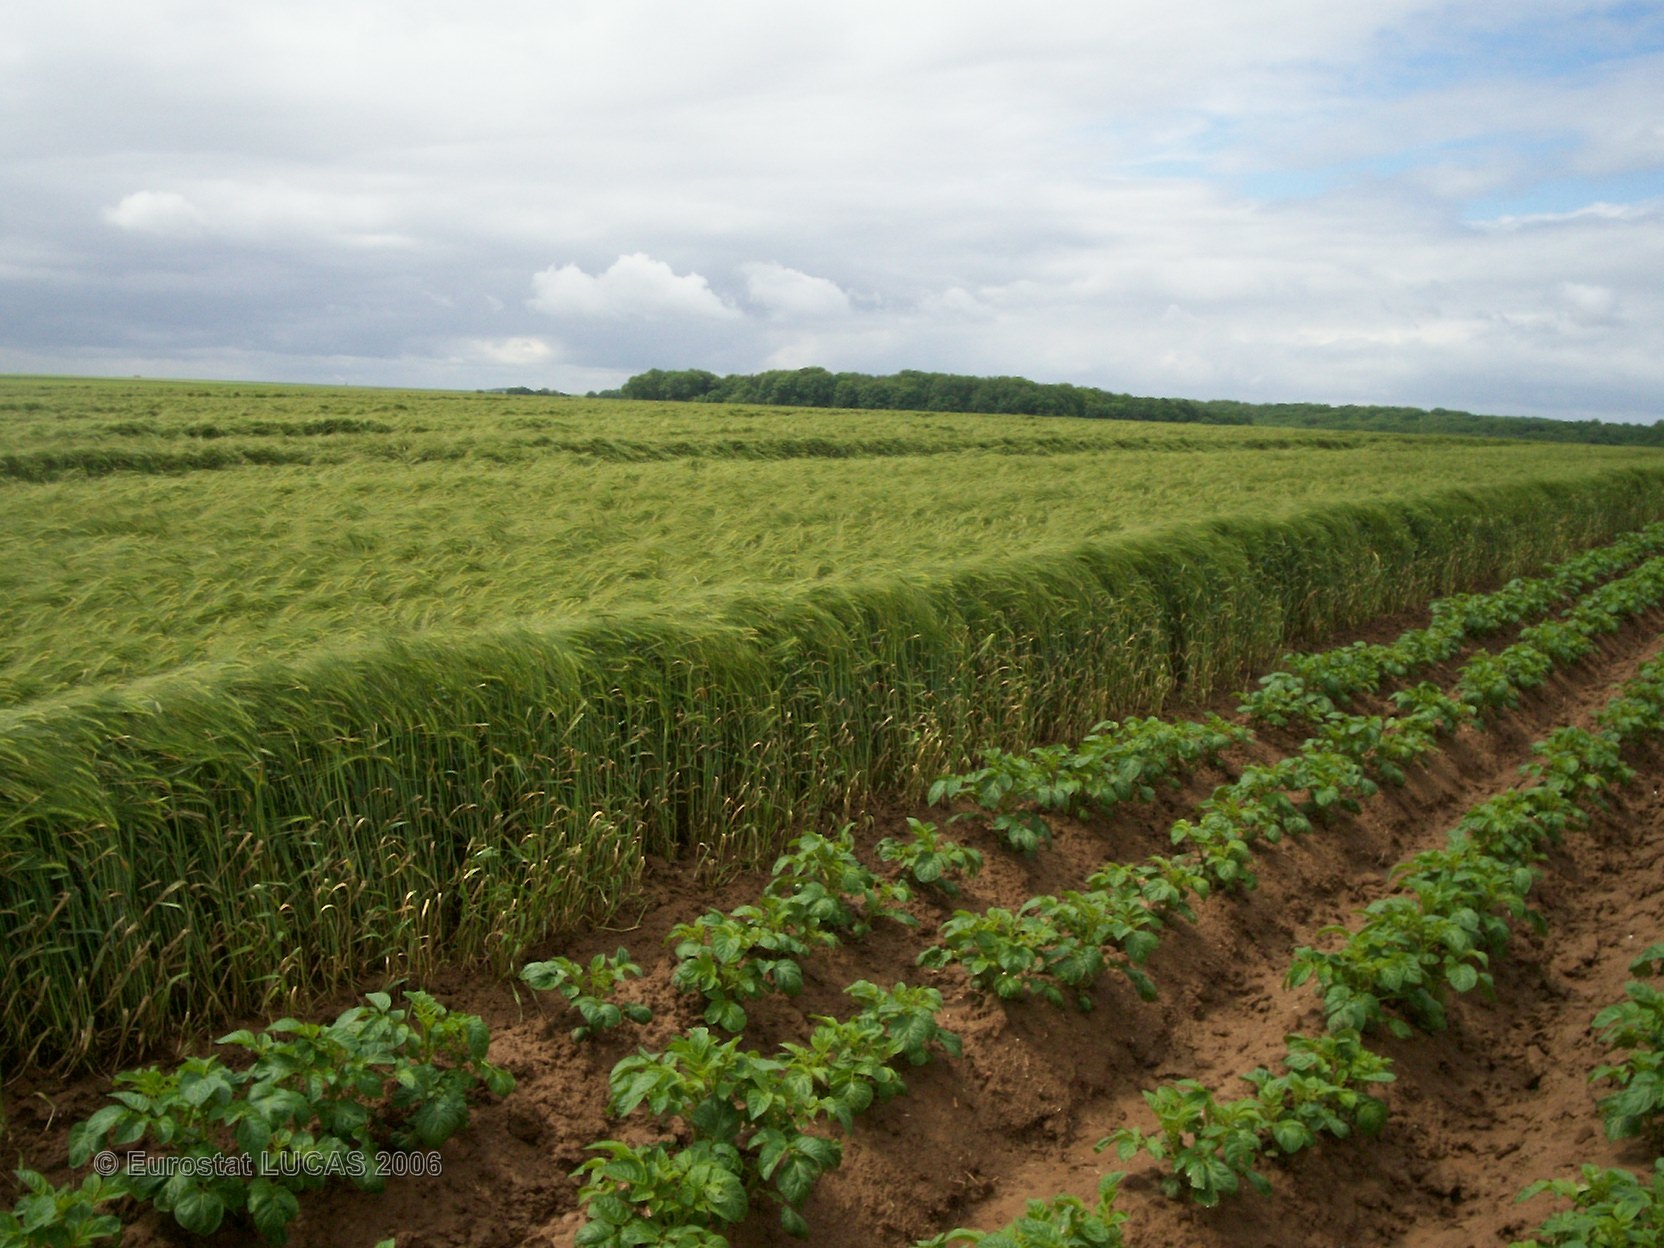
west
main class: Cropland
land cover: Potatoes
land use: Agriculture (excluding fallow land and kitchen gardens)
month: May
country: FR
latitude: 49.8893
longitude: 2.5972
